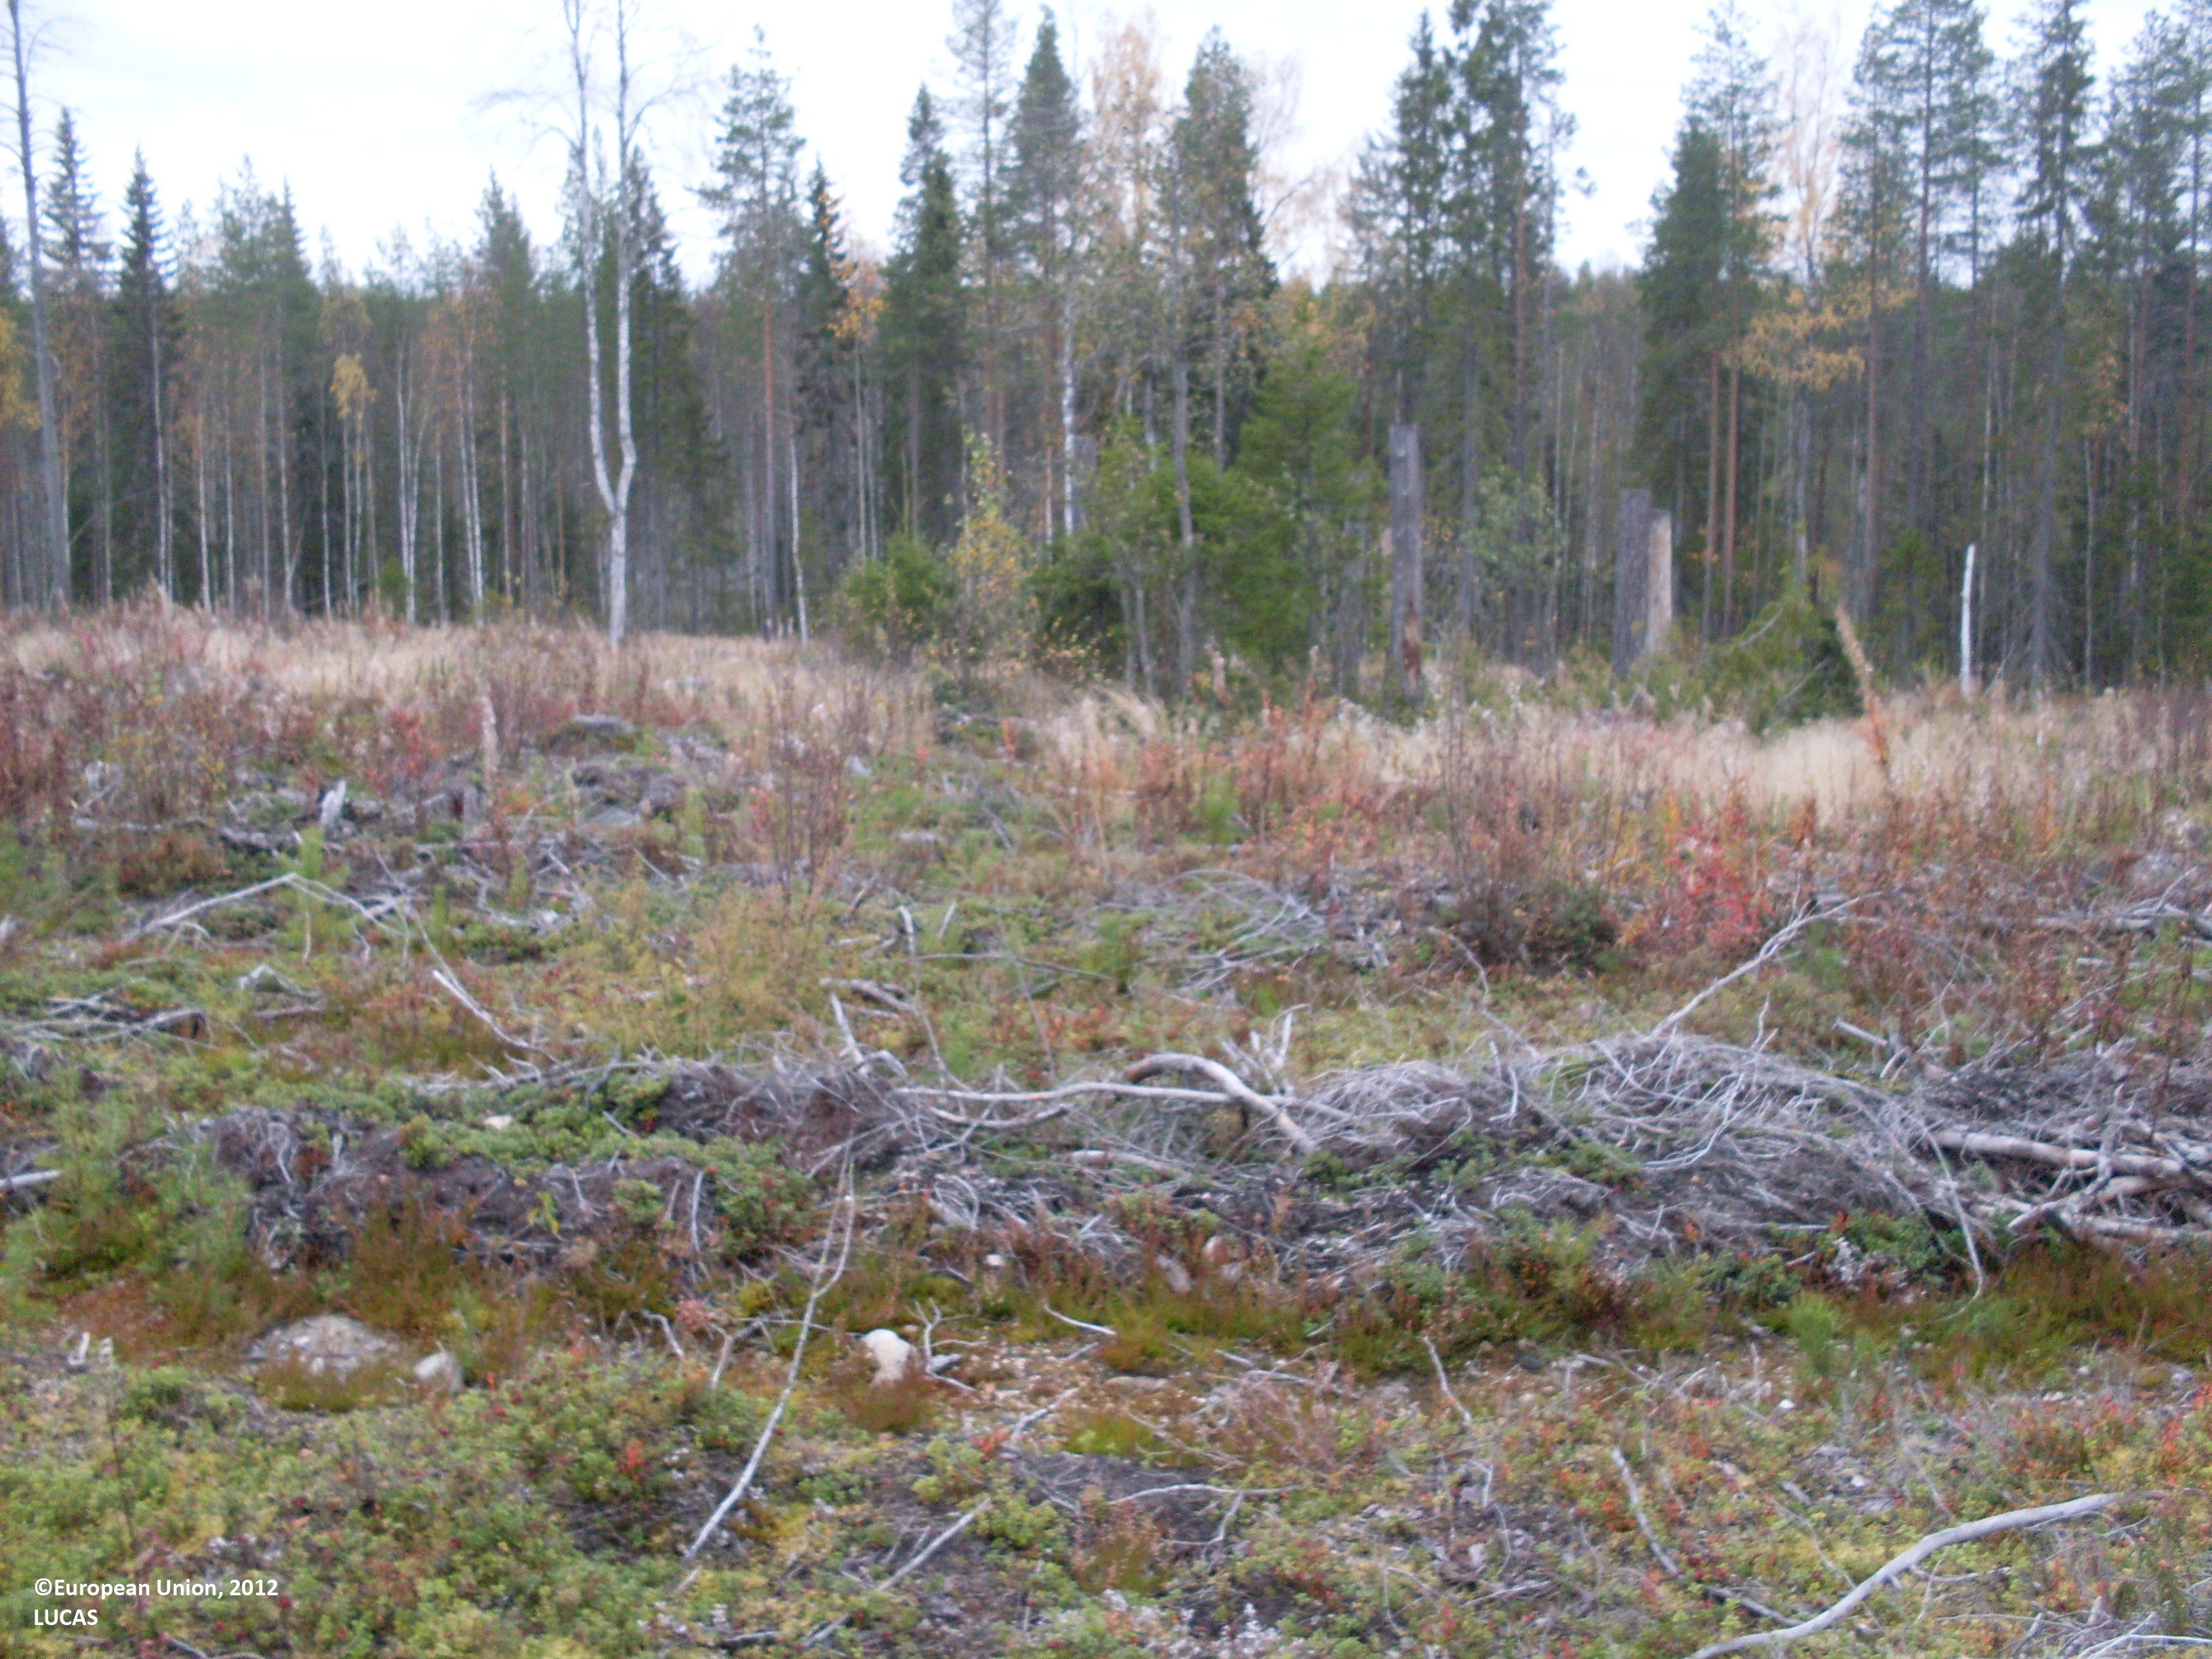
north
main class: Shrubland
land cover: Shrubland with sparse tree cover
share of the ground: > 75 %
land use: Forestry
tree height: < 5 m
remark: Clear cut
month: September
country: FI
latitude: 64.2601
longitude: 29.9010
